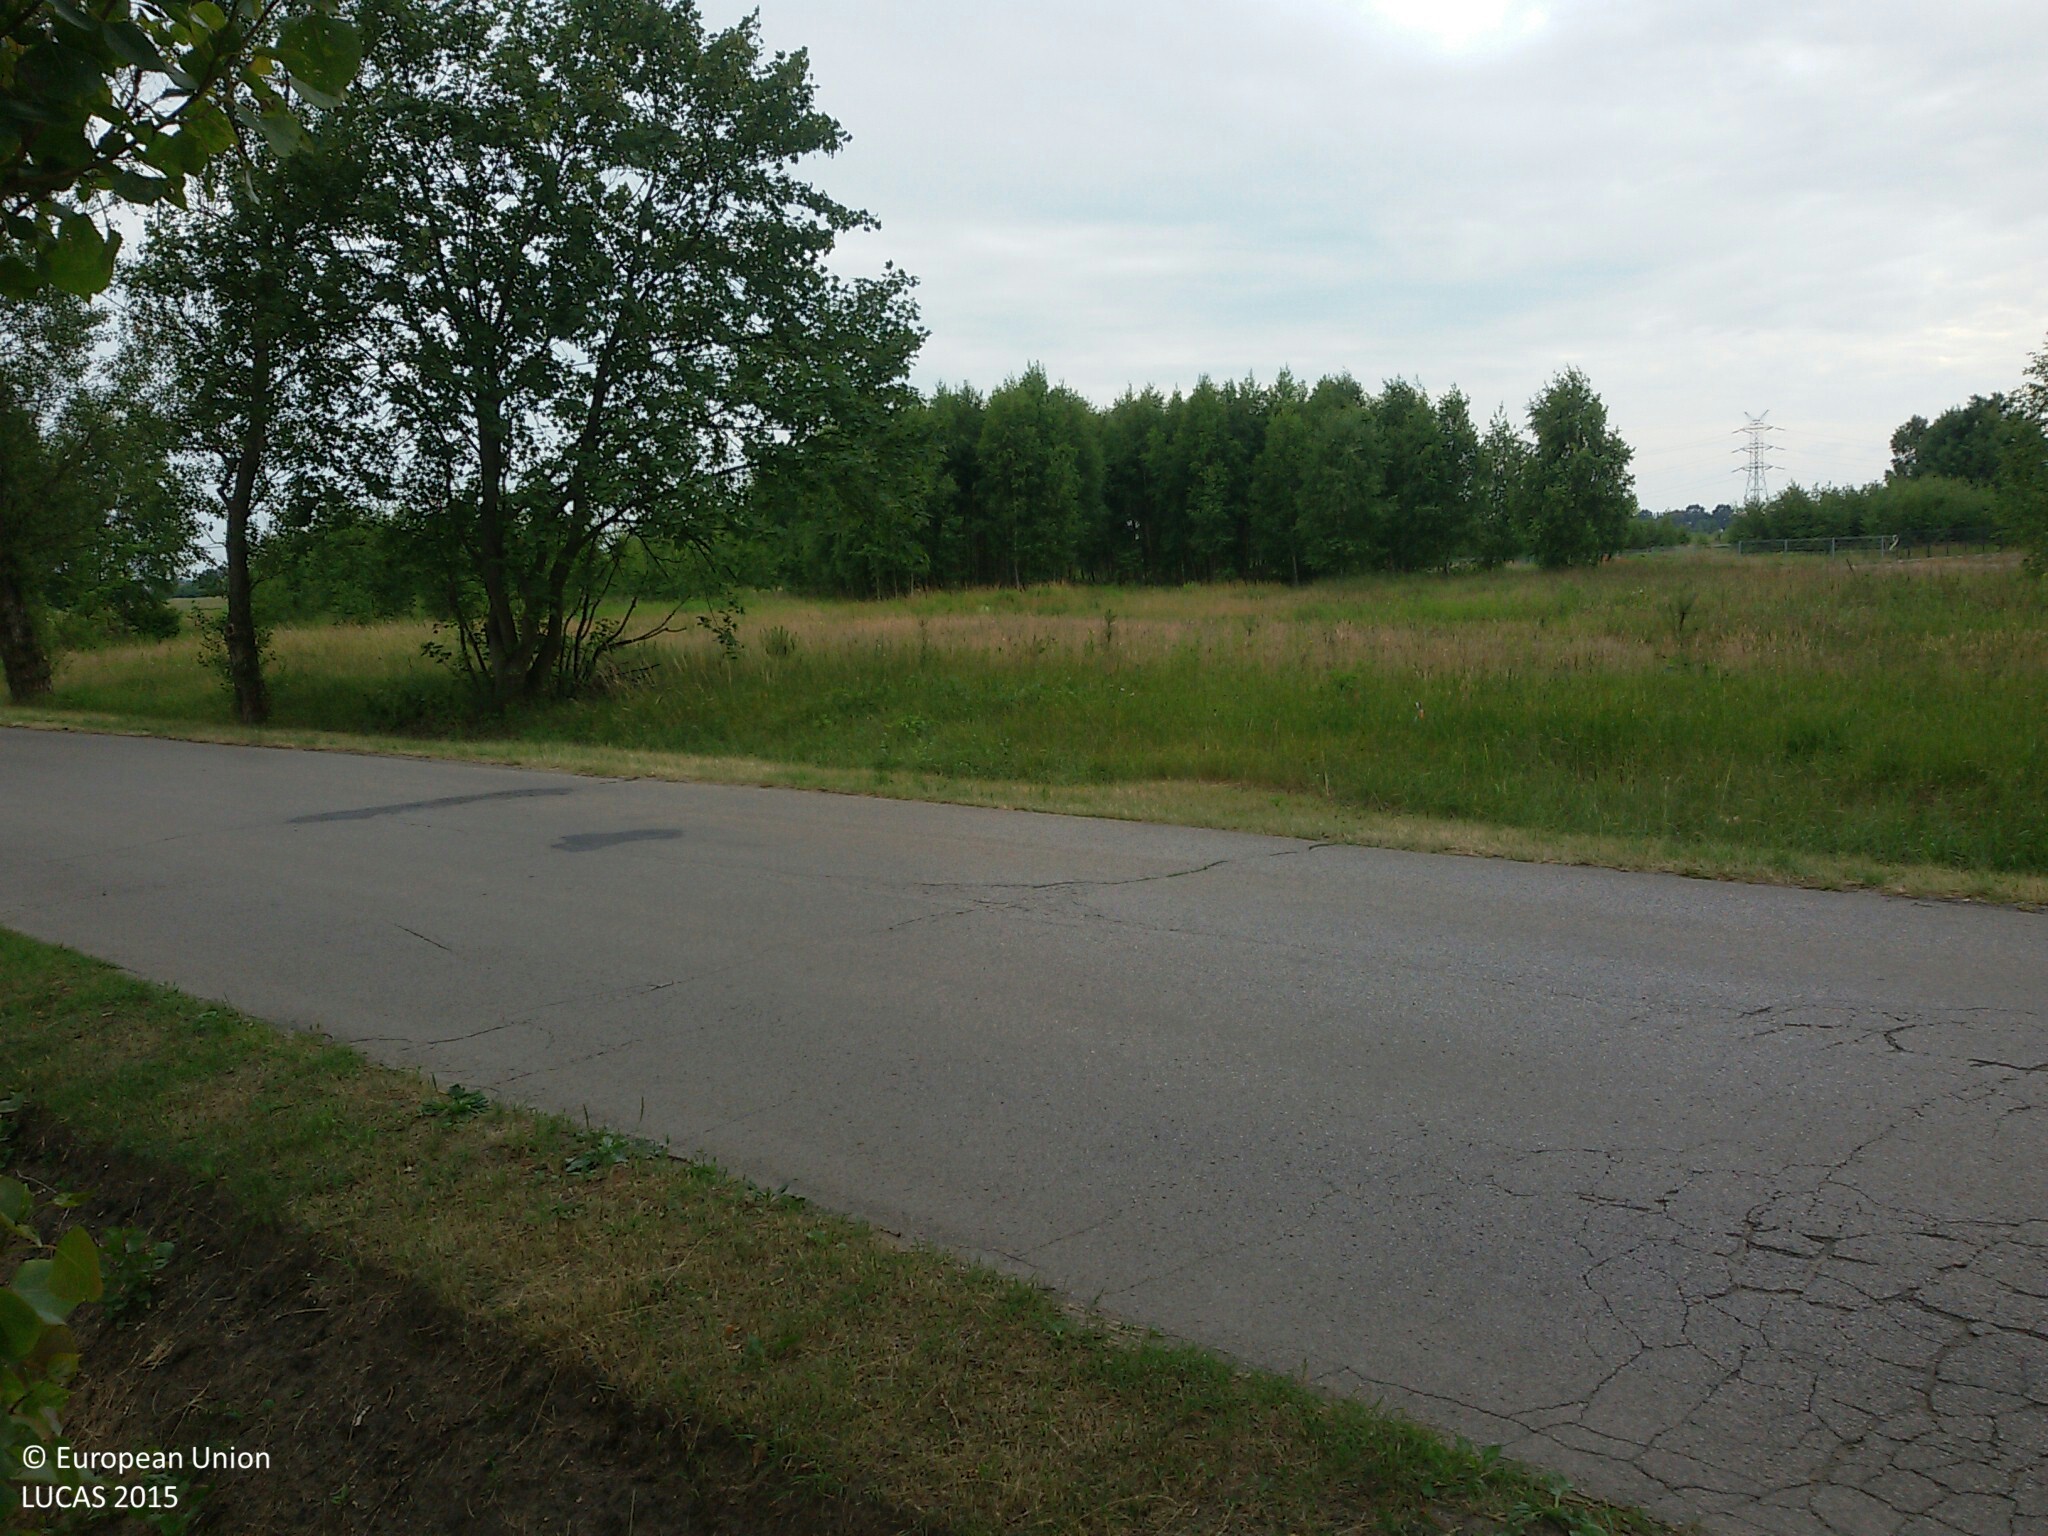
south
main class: Grassland
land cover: Grassland with sparse tree/shrub cover
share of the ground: > 75 %
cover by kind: herbaceous plants 95 %, broadleaved forest trees 5 %
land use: Road transport
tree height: > 5 m
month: June
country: PL
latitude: 52.2632
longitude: 20.8112
